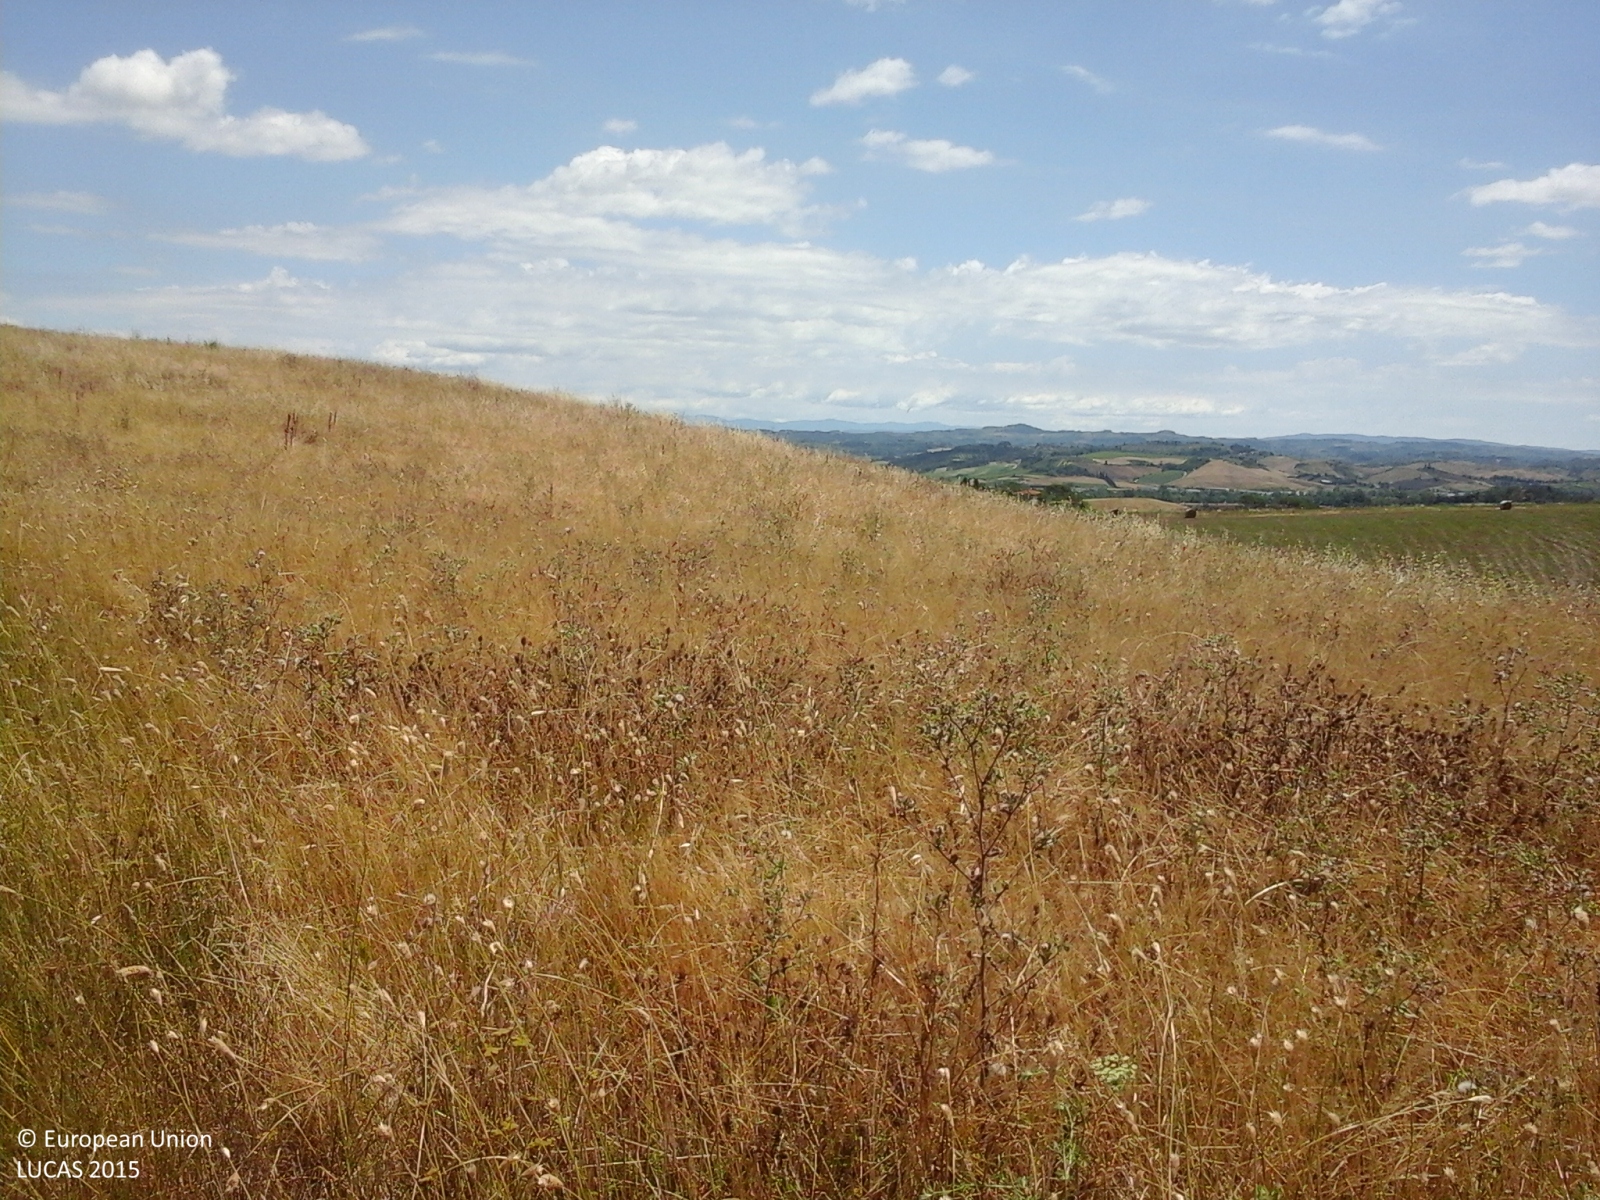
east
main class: Grassland
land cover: Grassland without tree/shrub cover
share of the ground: > 75 %
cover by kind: herbaceous plants 95 %, shrubs 5 %
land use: Agriculture (excluding fallow land and kitchen gardens)
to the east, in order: Grassland without tree/shrub cover; Abandoned hedges; Durum wheat; Abandoned hedges; Grassland without tree/shrub cover
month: June
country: IT
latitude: 43.5884
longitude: 10.9511
